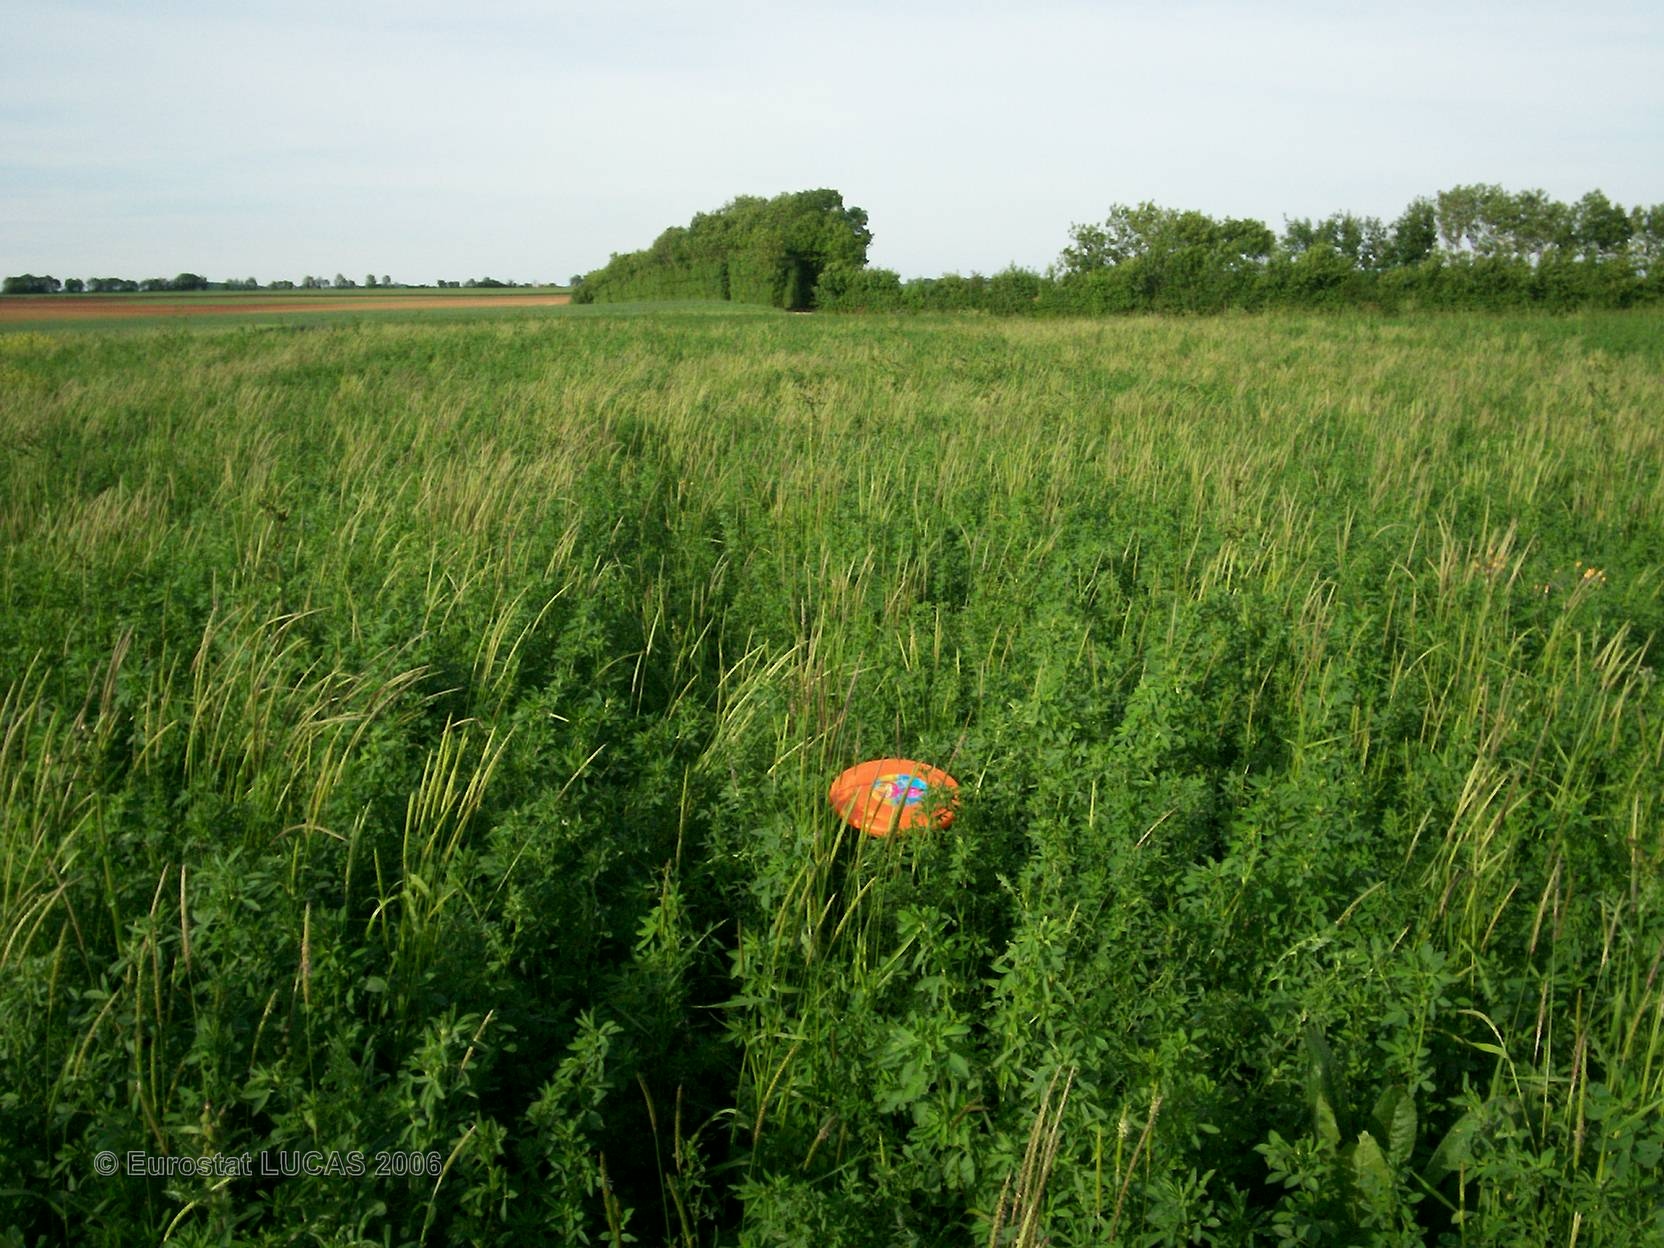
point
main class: Cropland
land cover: Lucerne
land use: Agriculture (excluding fallow land and kitchen gardens)
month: May
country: FR
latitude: 46.1540
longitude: -0.1863
